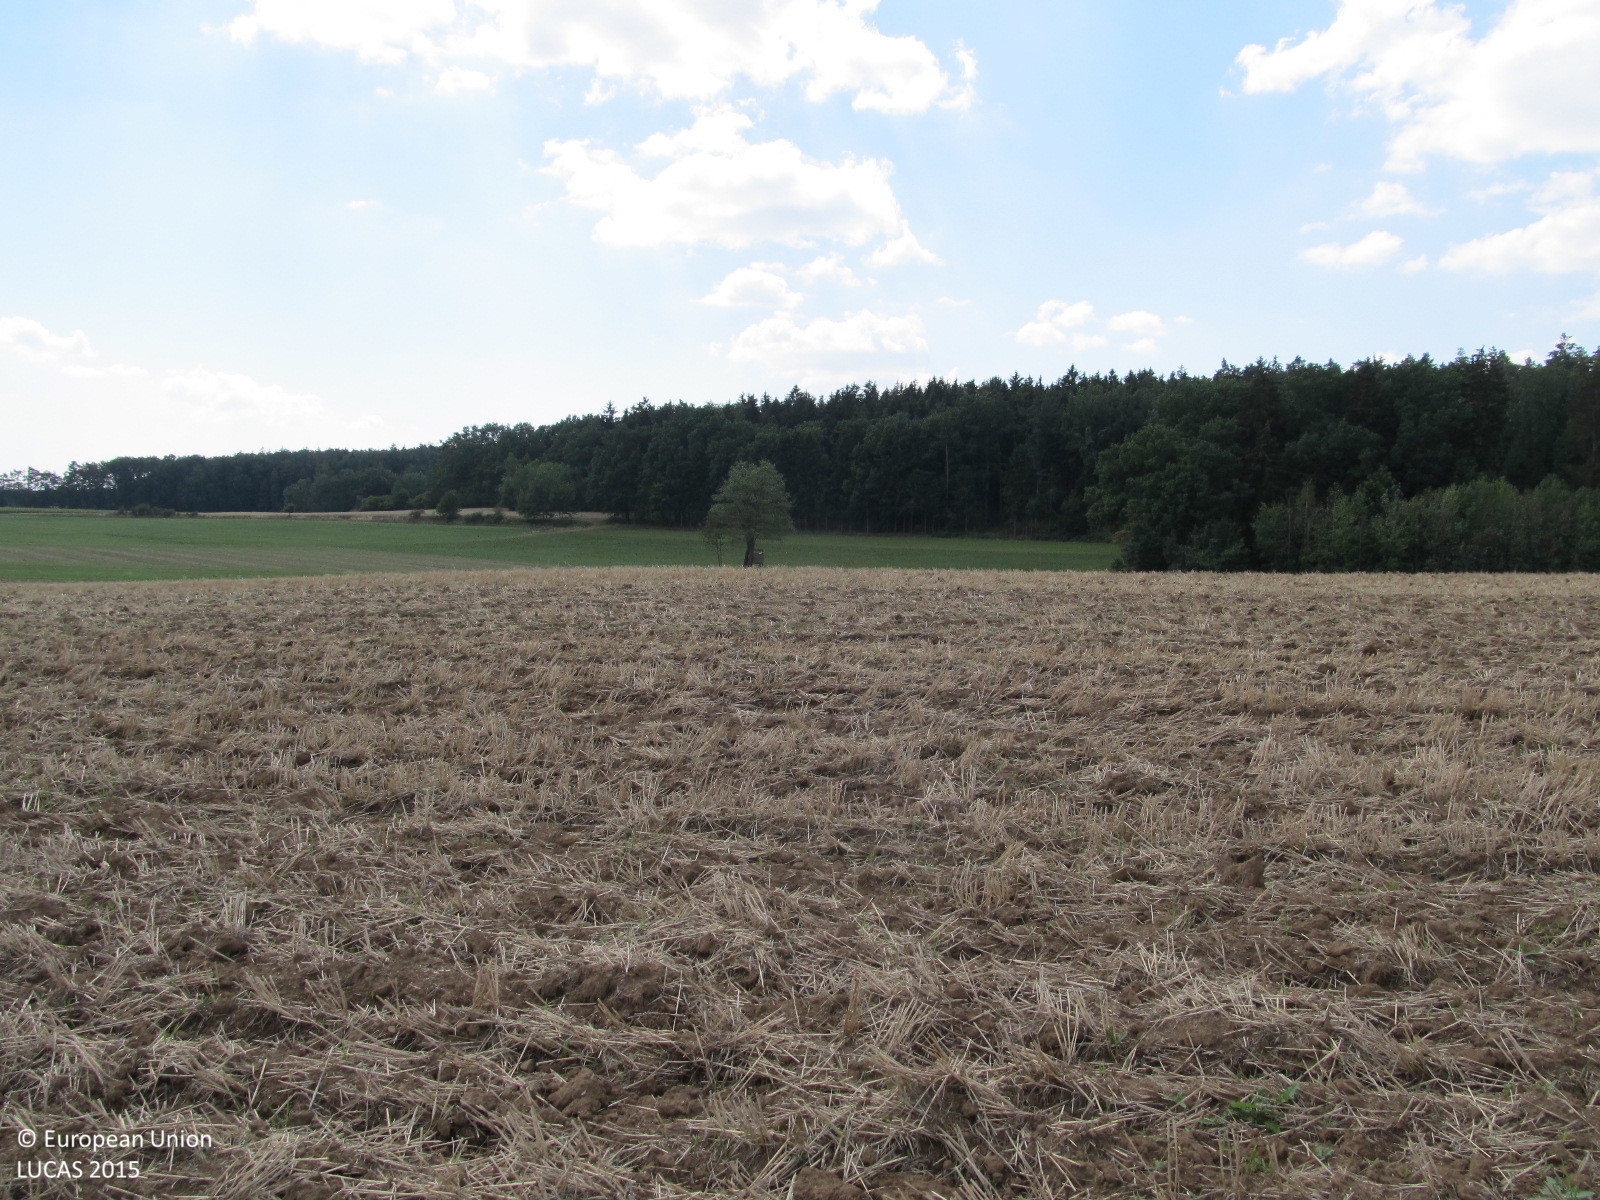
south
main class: Cropland
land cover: Barley
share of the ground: < 10 %
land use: Agriculture (excluding fallow land and kitchen gardens)
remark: Harvested field
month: August
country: AT
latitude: 48.6041
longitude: 15.6041
